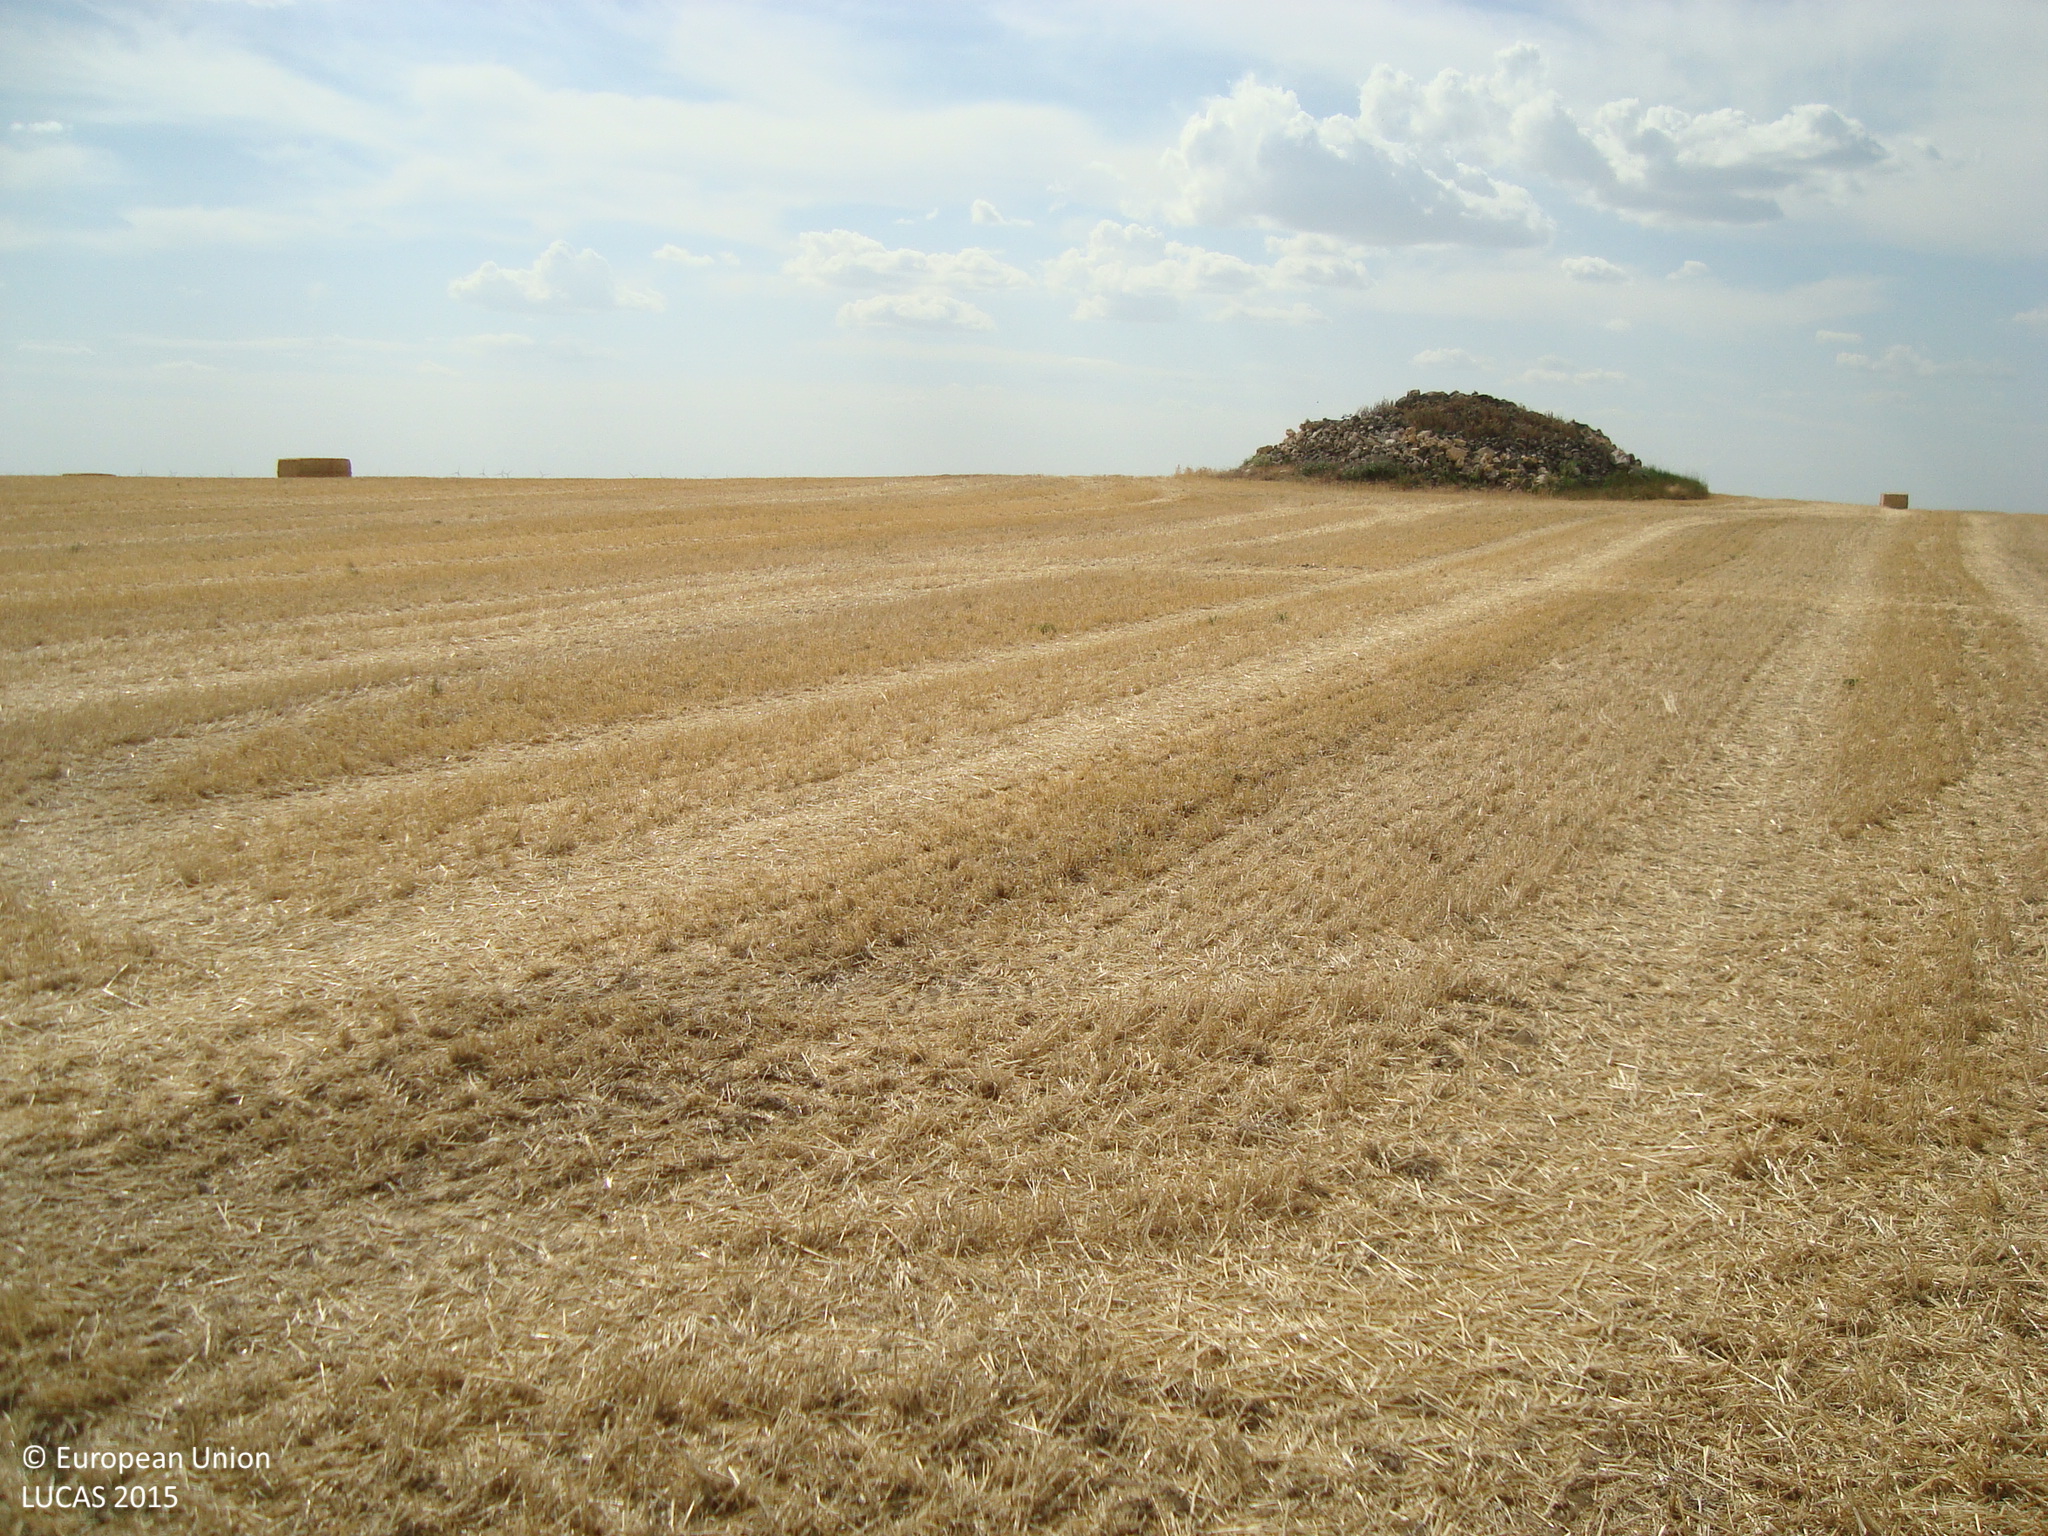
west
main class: Cropland
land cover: Barley
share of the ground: > 75 %
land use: Agriculture (excluding fallow land and kitchen gardens)
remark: Harvested field
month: July
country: ES
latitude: 41.9914
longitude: -4.1016
